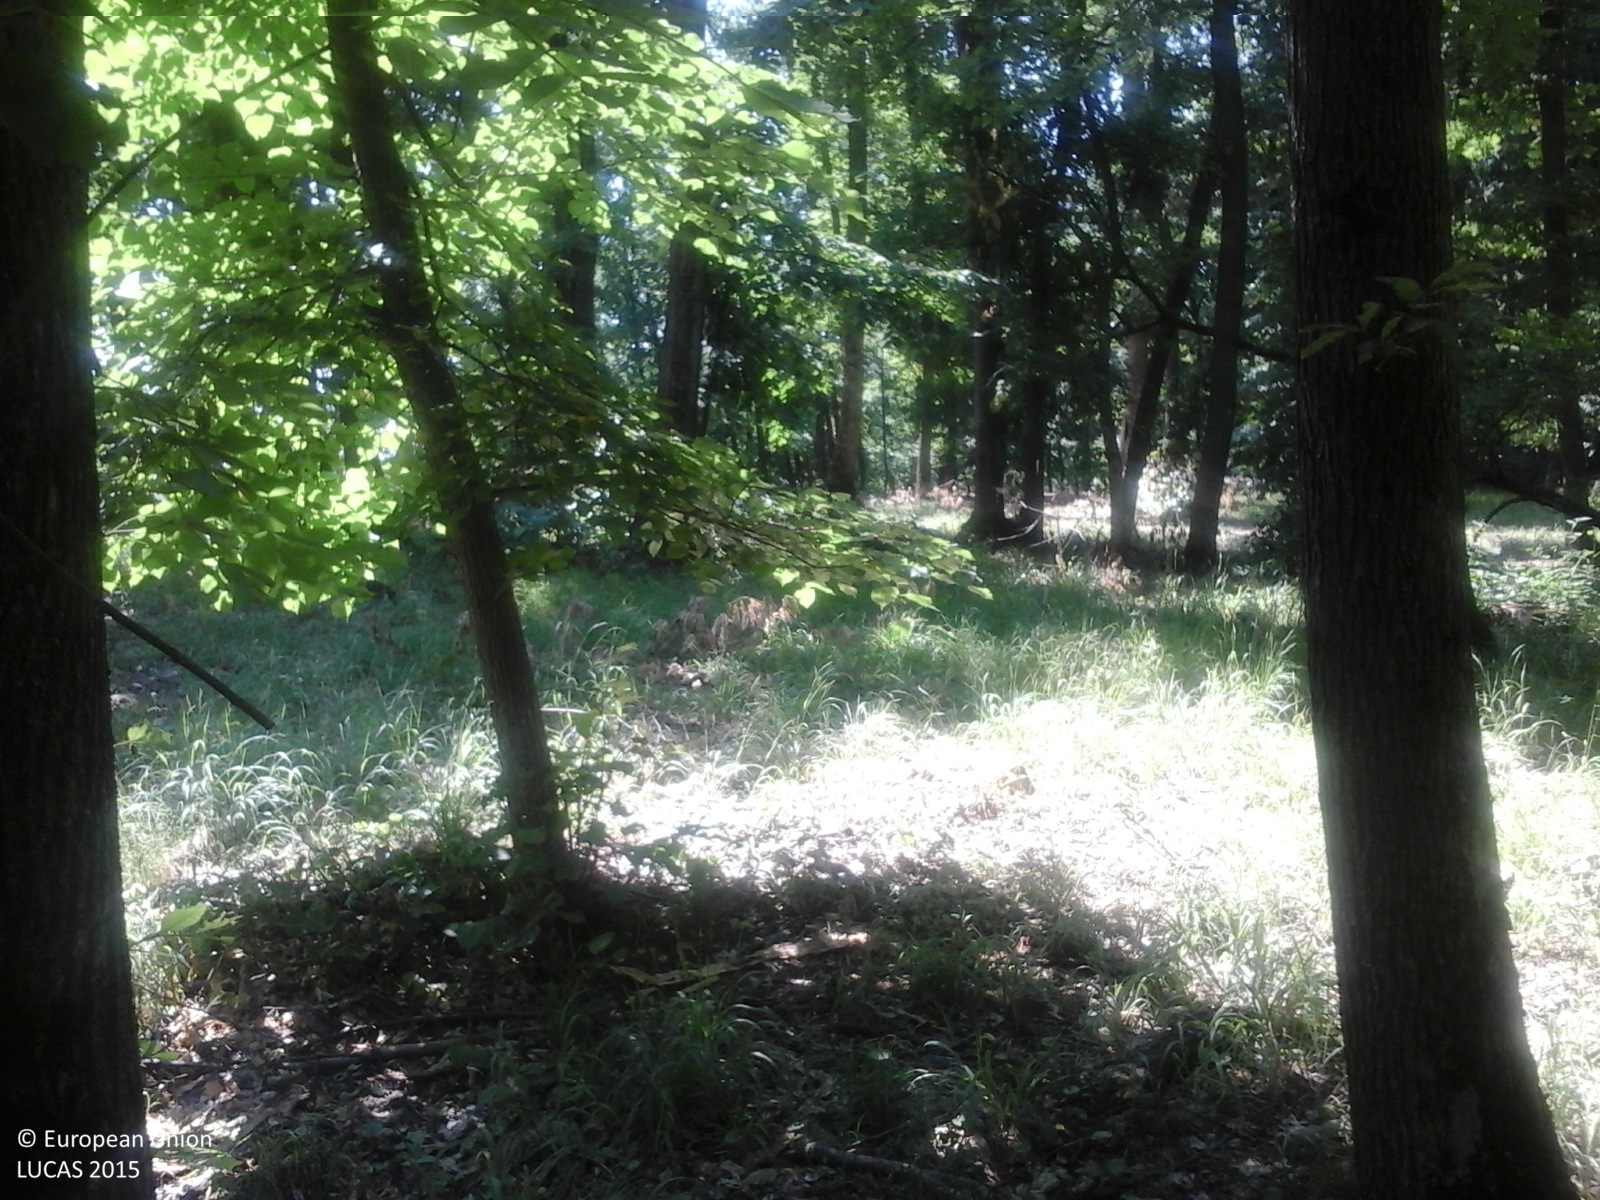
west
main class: Woodland
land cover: Broadleaved woodland
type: beech forest
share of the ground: > 75 %
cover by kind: broadleaved forest trees 85 %, herbaceous plants 15 %
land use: Forestry
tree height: > 5 m
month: June
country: RO
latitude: 46.8401
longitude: 27.8656
